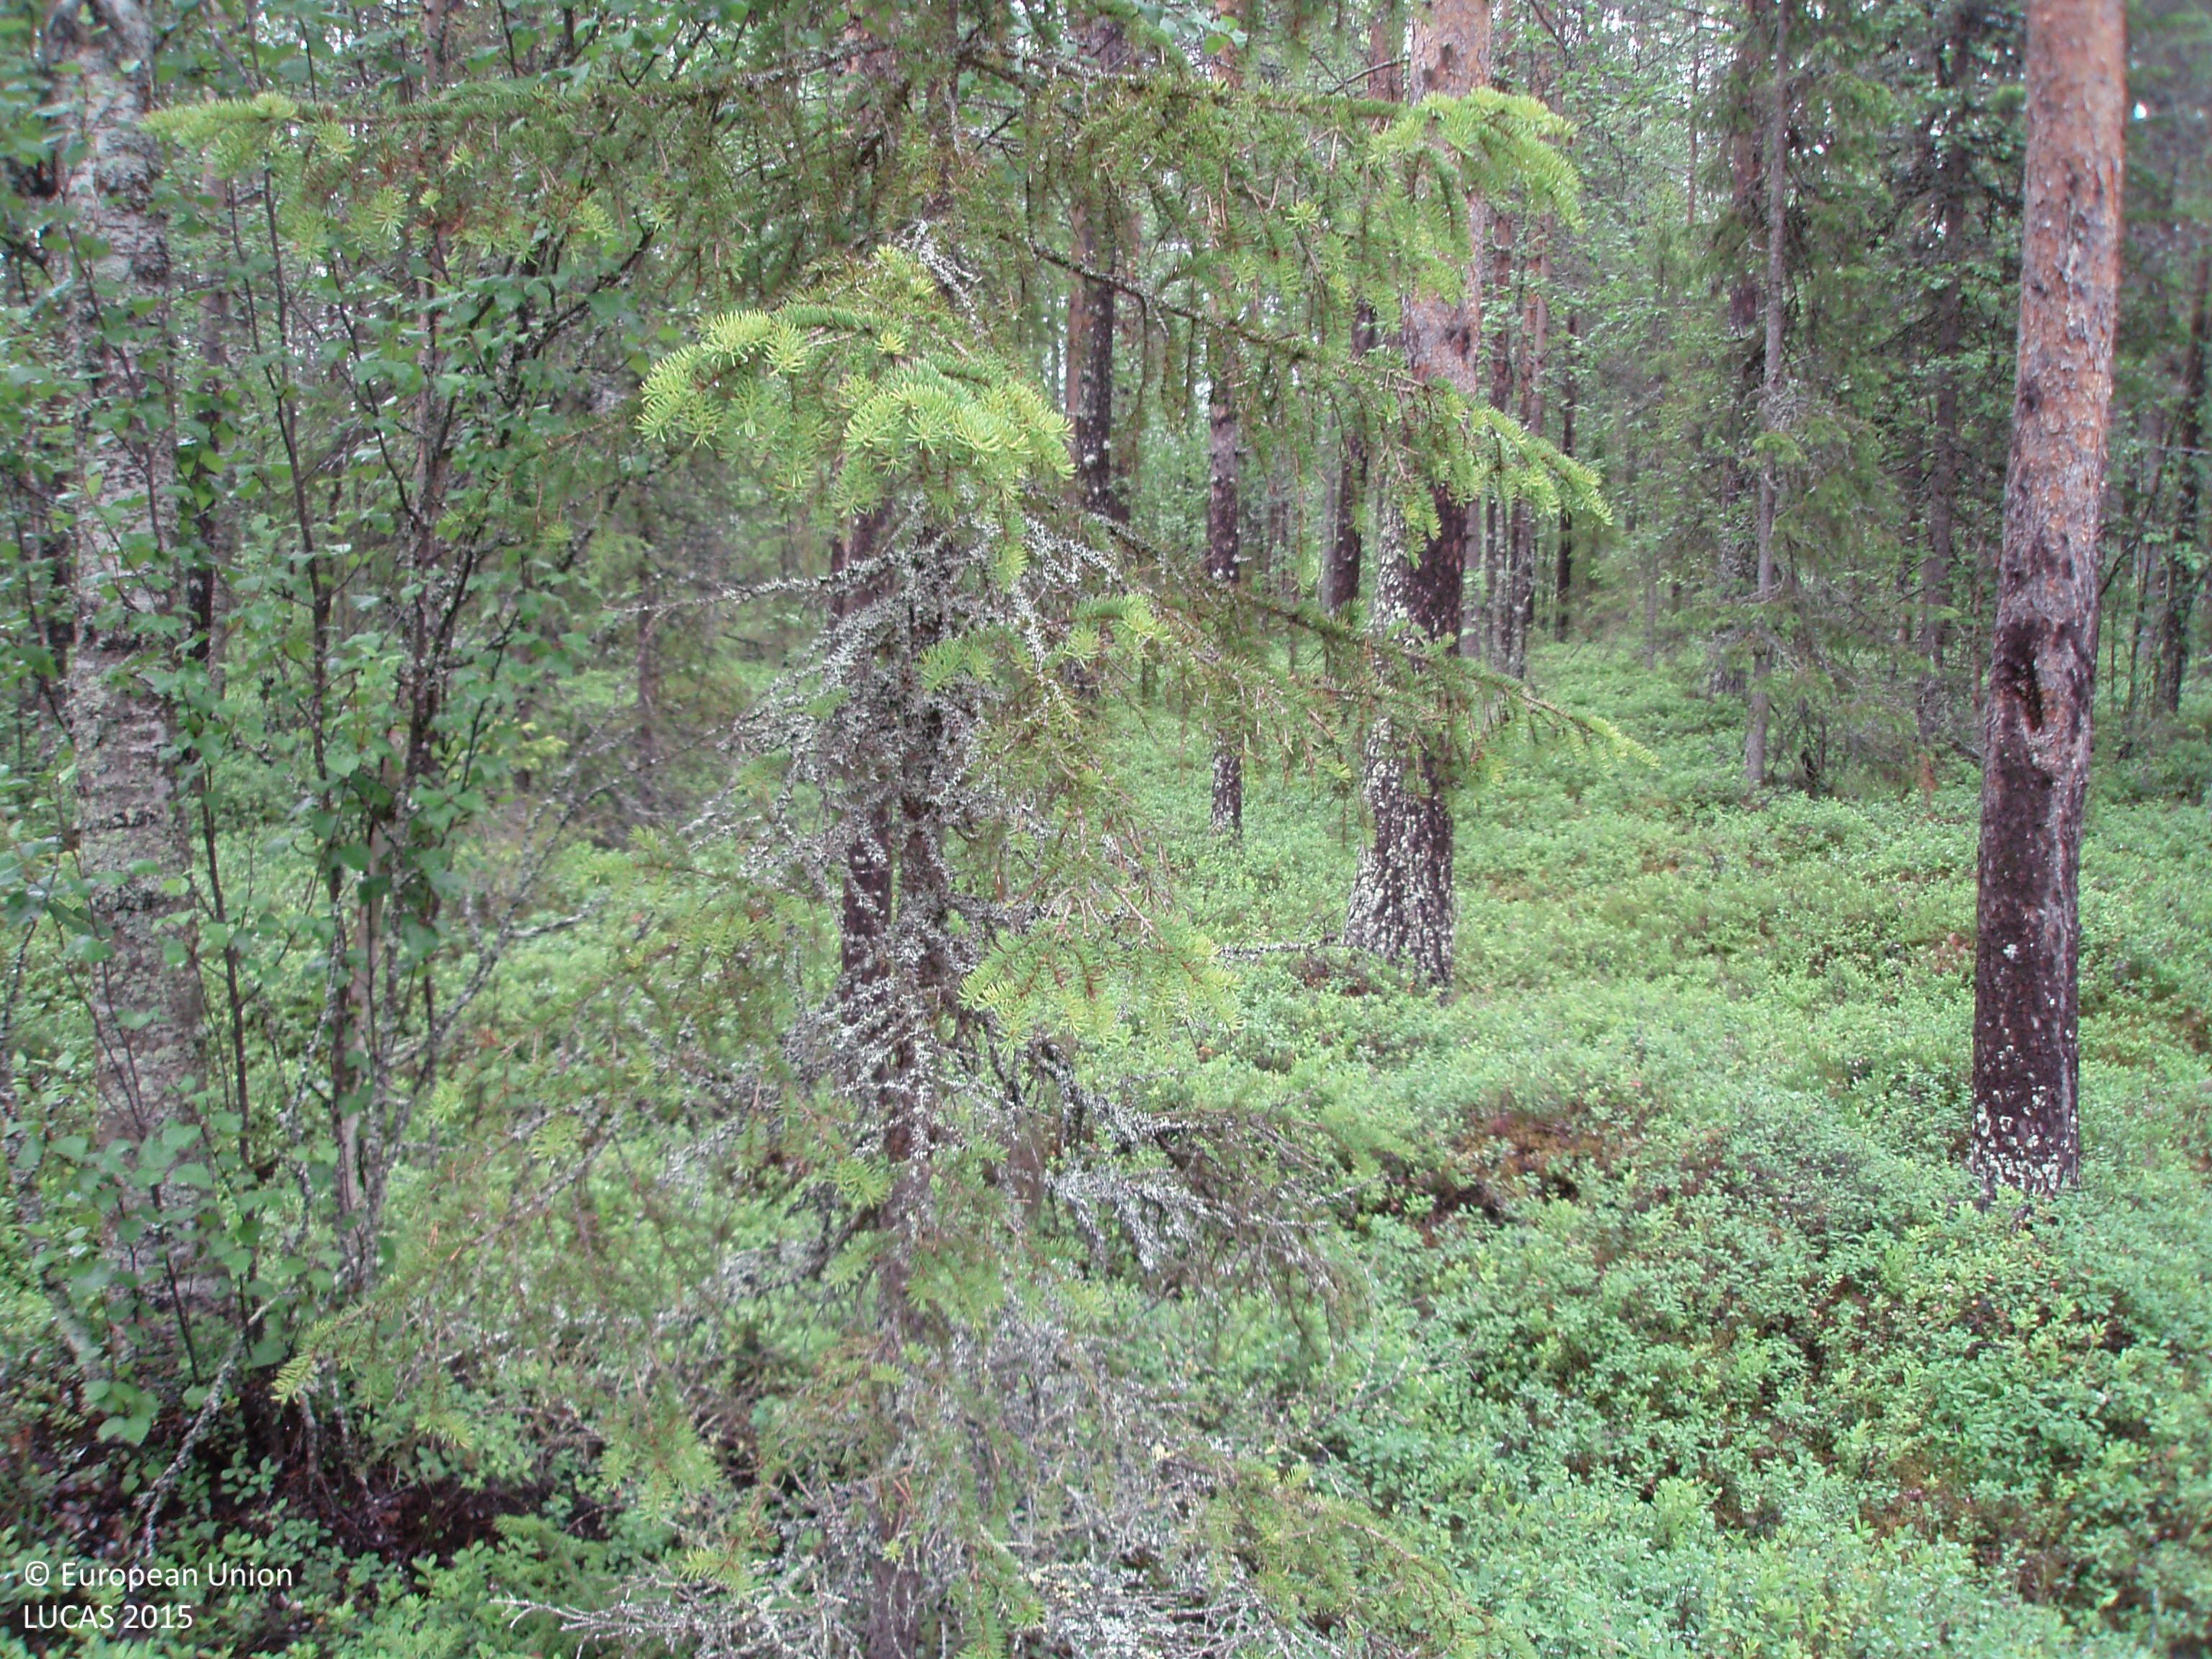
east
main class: Woodland
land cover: Pine dominated mixed woodland
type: boreal forest
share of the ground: > 75 %
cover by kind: coniferous forest trees 60 %, broadleaved forest trees 25 %, shrubs 15 %
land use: Forestry
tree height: > 5 m
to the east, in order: Pine dominated mixed woodland; Ditches and canals; Pine dominated mixed woodland; Ditches and canals; Pine dominated mixed woodland; Tracks; Ditches and canals; Broadleaved woodland; Ditches and canals; Broadleaved woodland; Ditches and canals; Broadleaved woodland; Ditches and canals; Broadleaved woodland; Ditches and canals; Broadleaved woodland; Ditches and canals; Spruce dominated mixed woodland
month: July
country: FI
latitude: 67.0908
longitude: 28.8638
